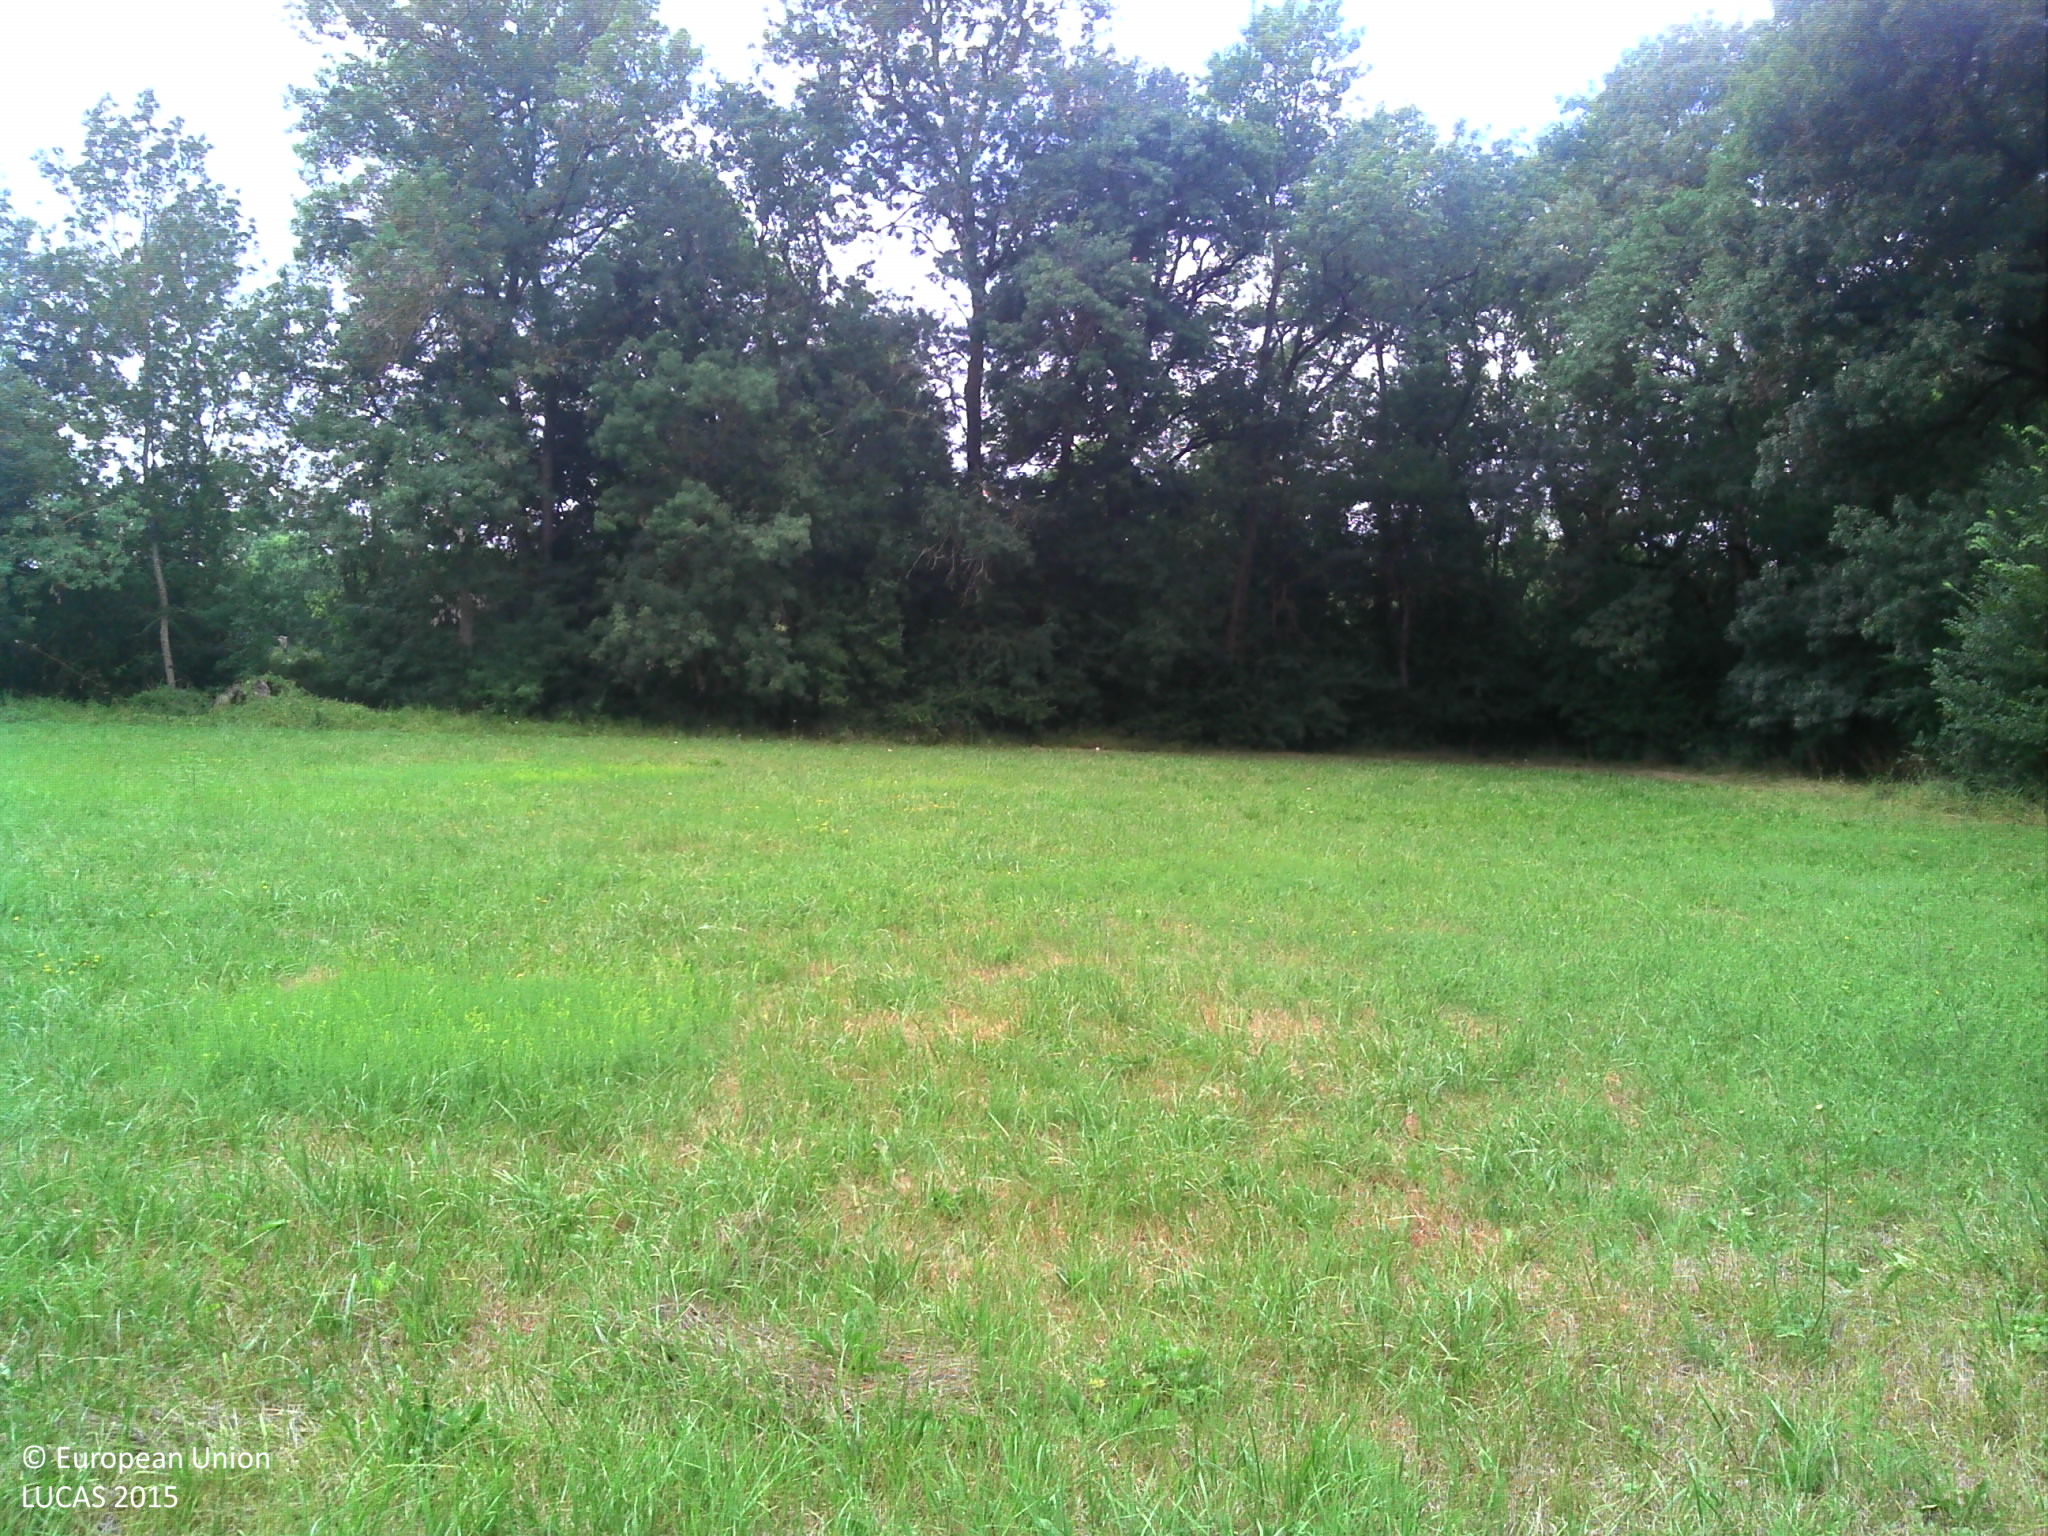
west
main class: Grassland
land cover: Grassland without tree/shrub cover
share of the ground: > 75 %
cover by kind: herbaceous plants 100 %
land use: Agriculture (excluding fallow land and kitchen gardens)
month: July
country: FR
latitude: 43.8059
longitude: 0.9121
